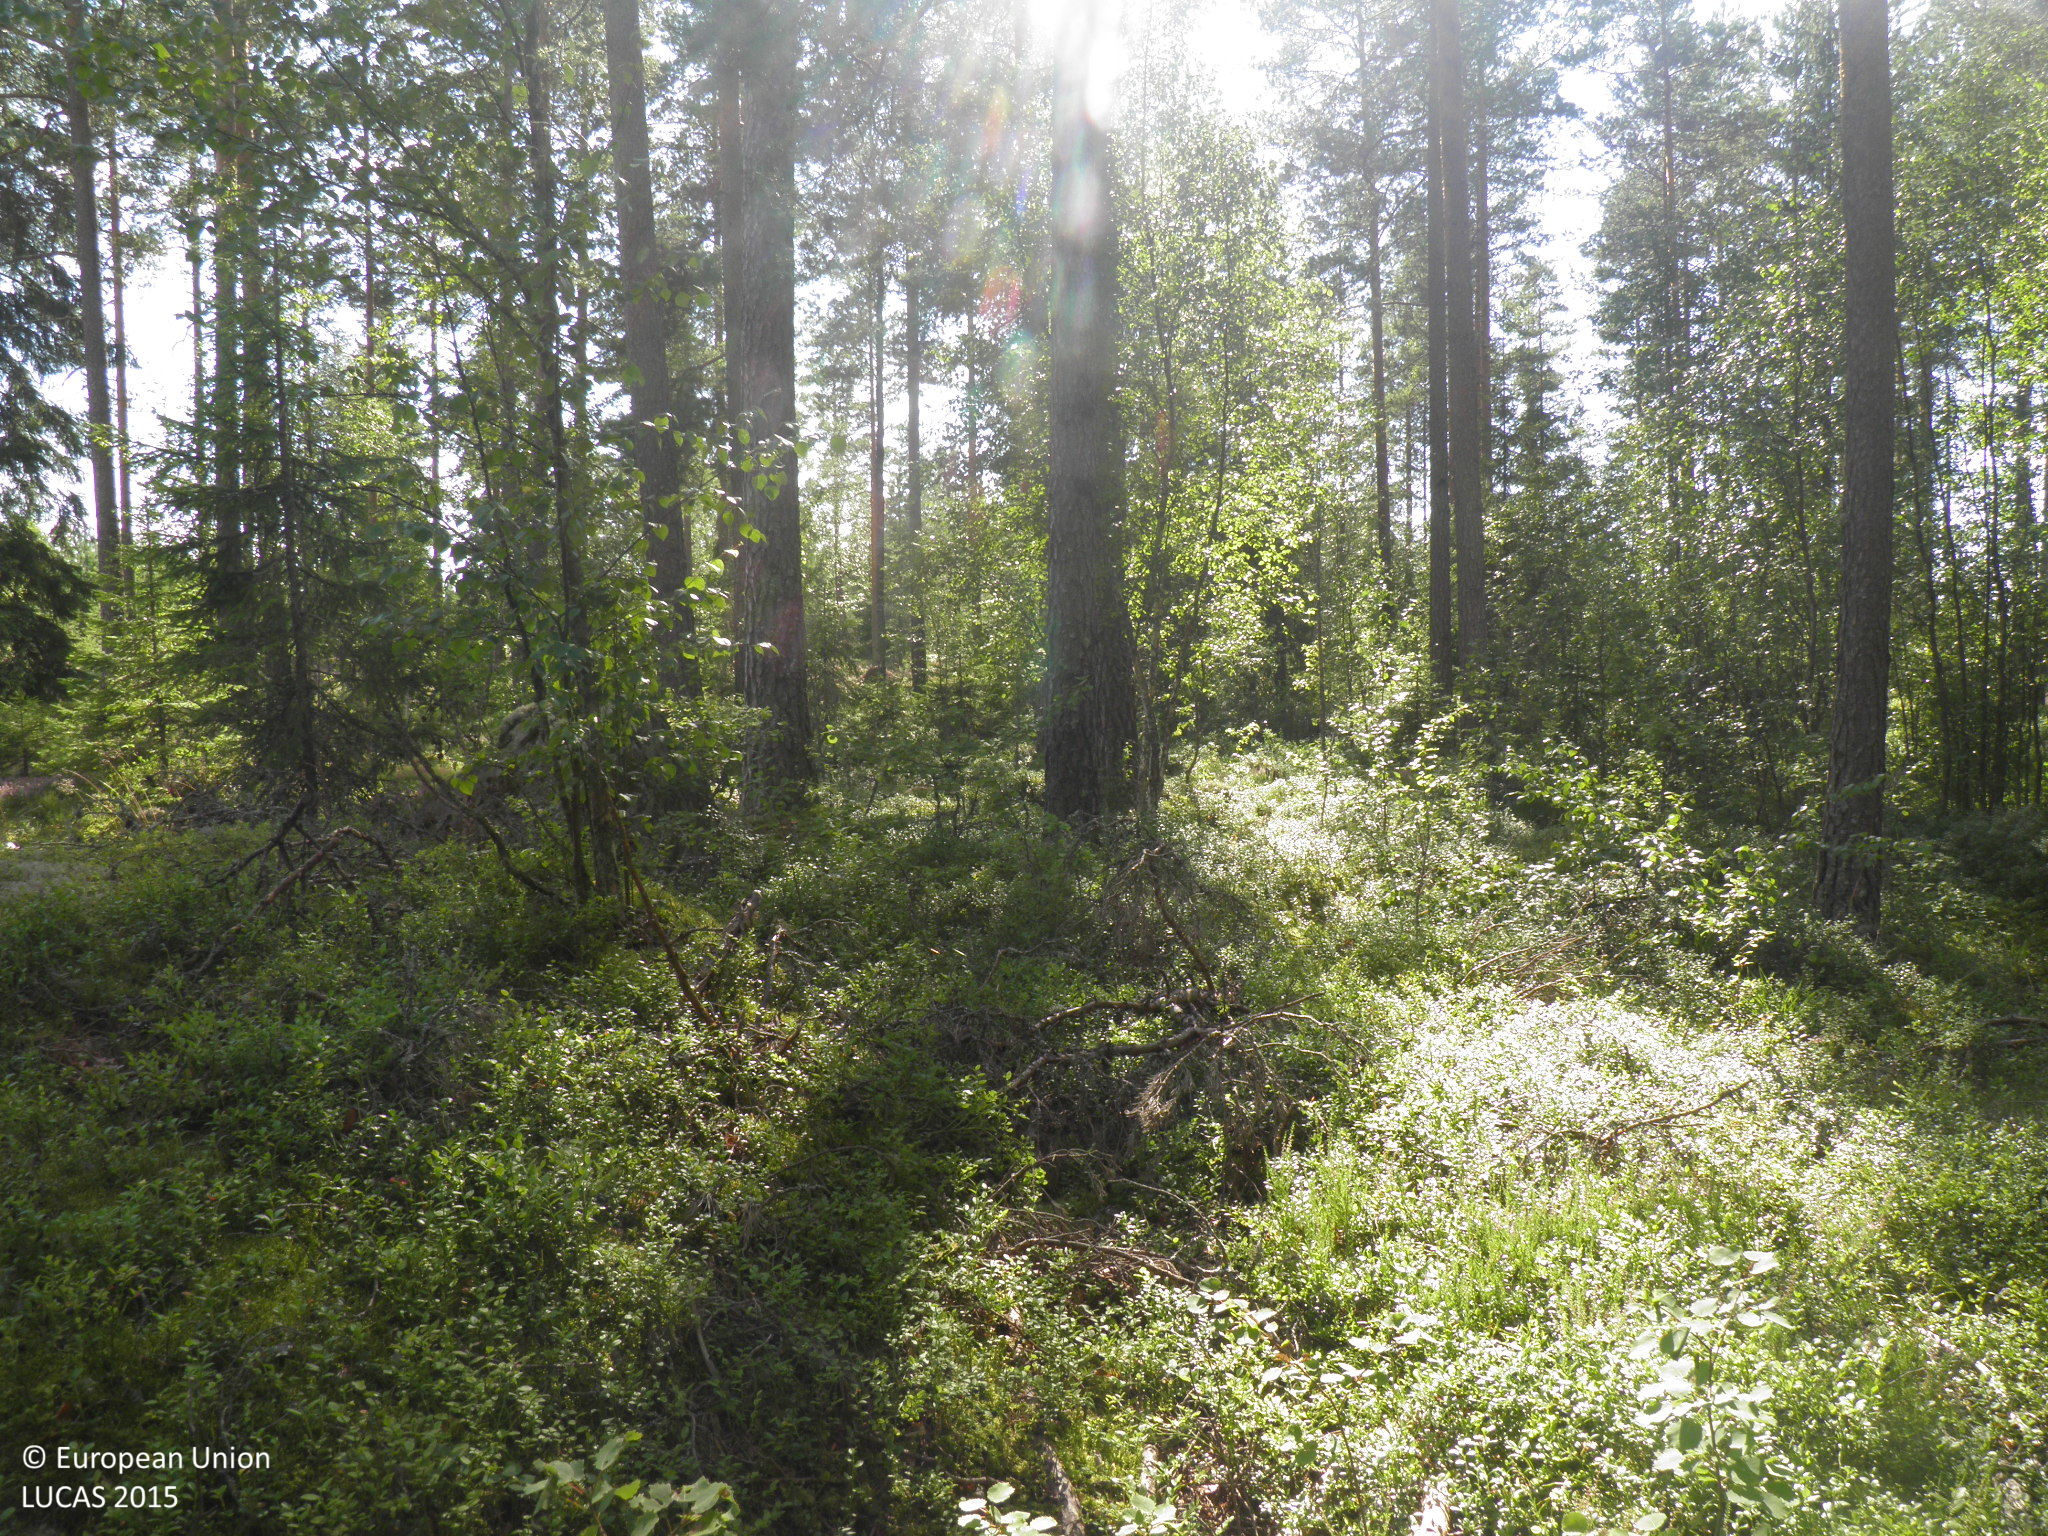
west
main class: Woodland
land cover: Spruce dominated coniferous woodland
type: hemiboreal forest and nemoral coniferous forest and mixed broadleaved-coniferous forest
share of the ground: 50 - 75 %
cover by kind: coniferous forest trees 70 %, shrubs 15 %, lichens and mosses 15 %
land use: Forestry
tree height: > 5 m
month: August
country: FI
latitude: 61.0291
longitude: 21.8472
